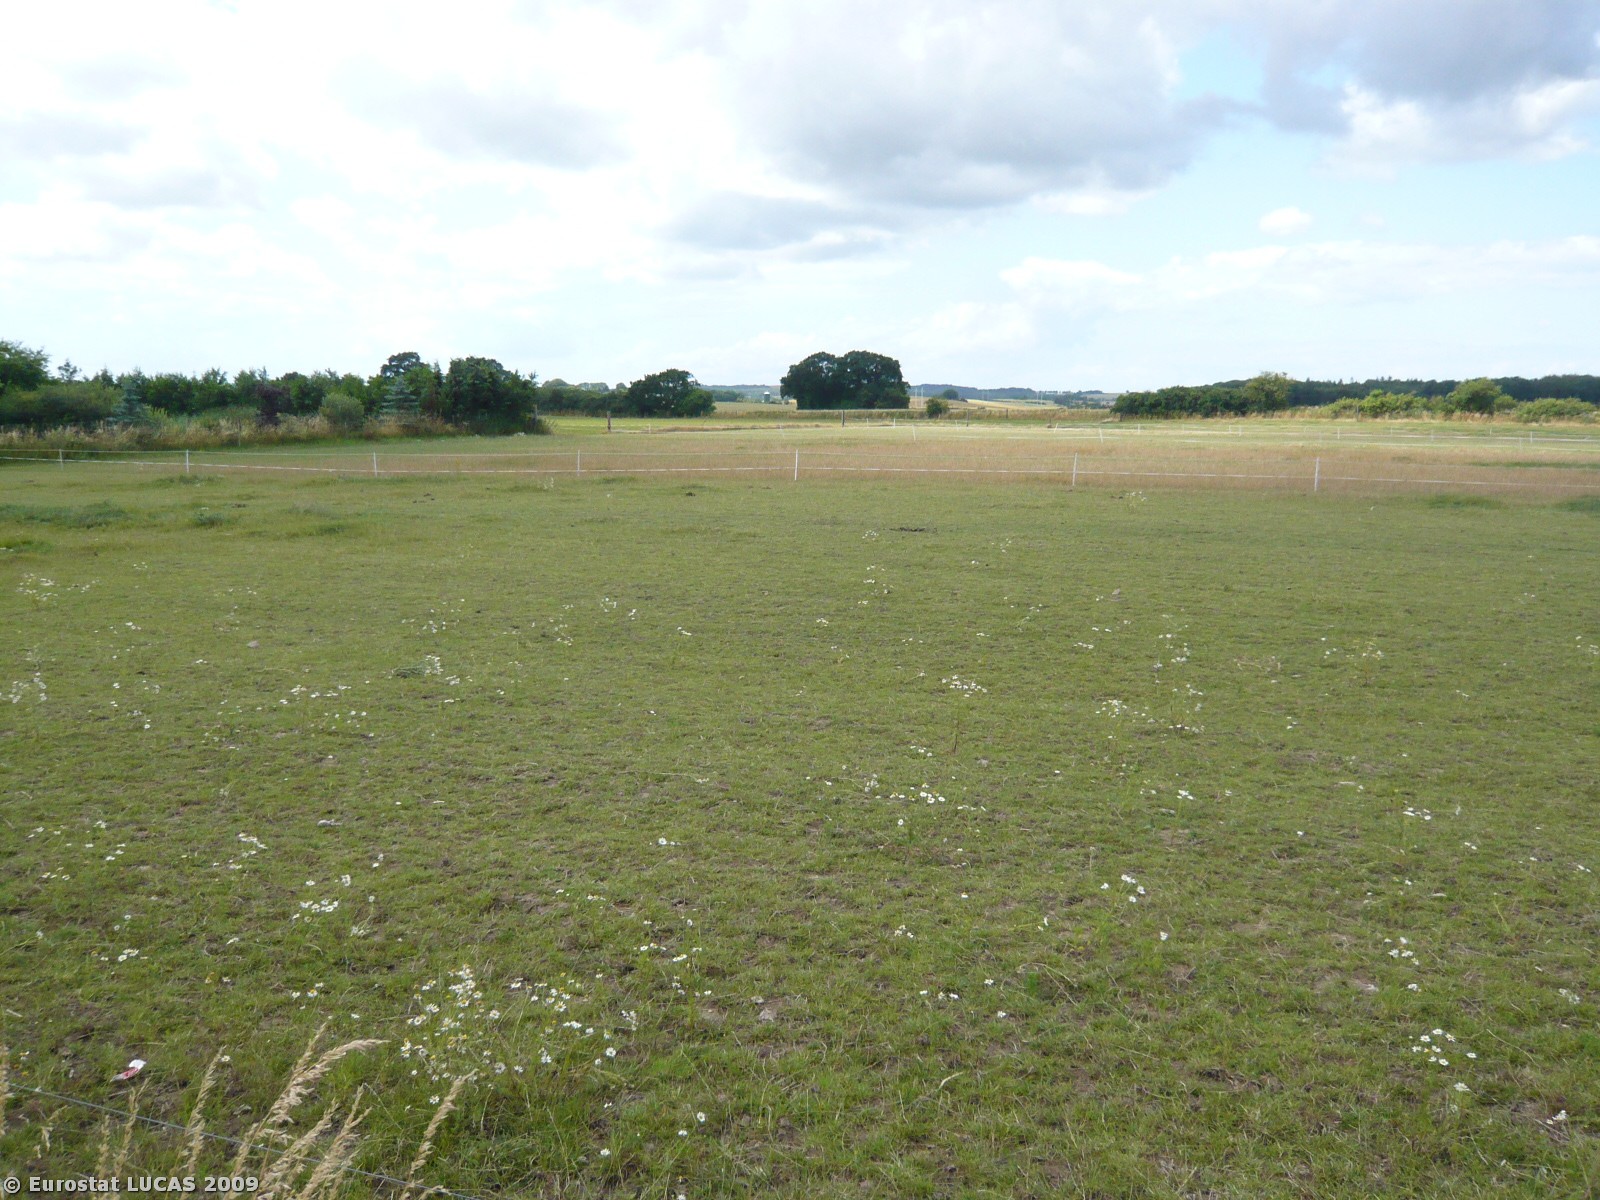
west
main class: Grassland
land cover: Grassland without tree/shrub cover
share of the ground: > 75 %
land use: Agriculture (excluding fallow land and kitchen gardens)
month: July
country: DK
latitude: 55.5684
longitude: 11.4418
